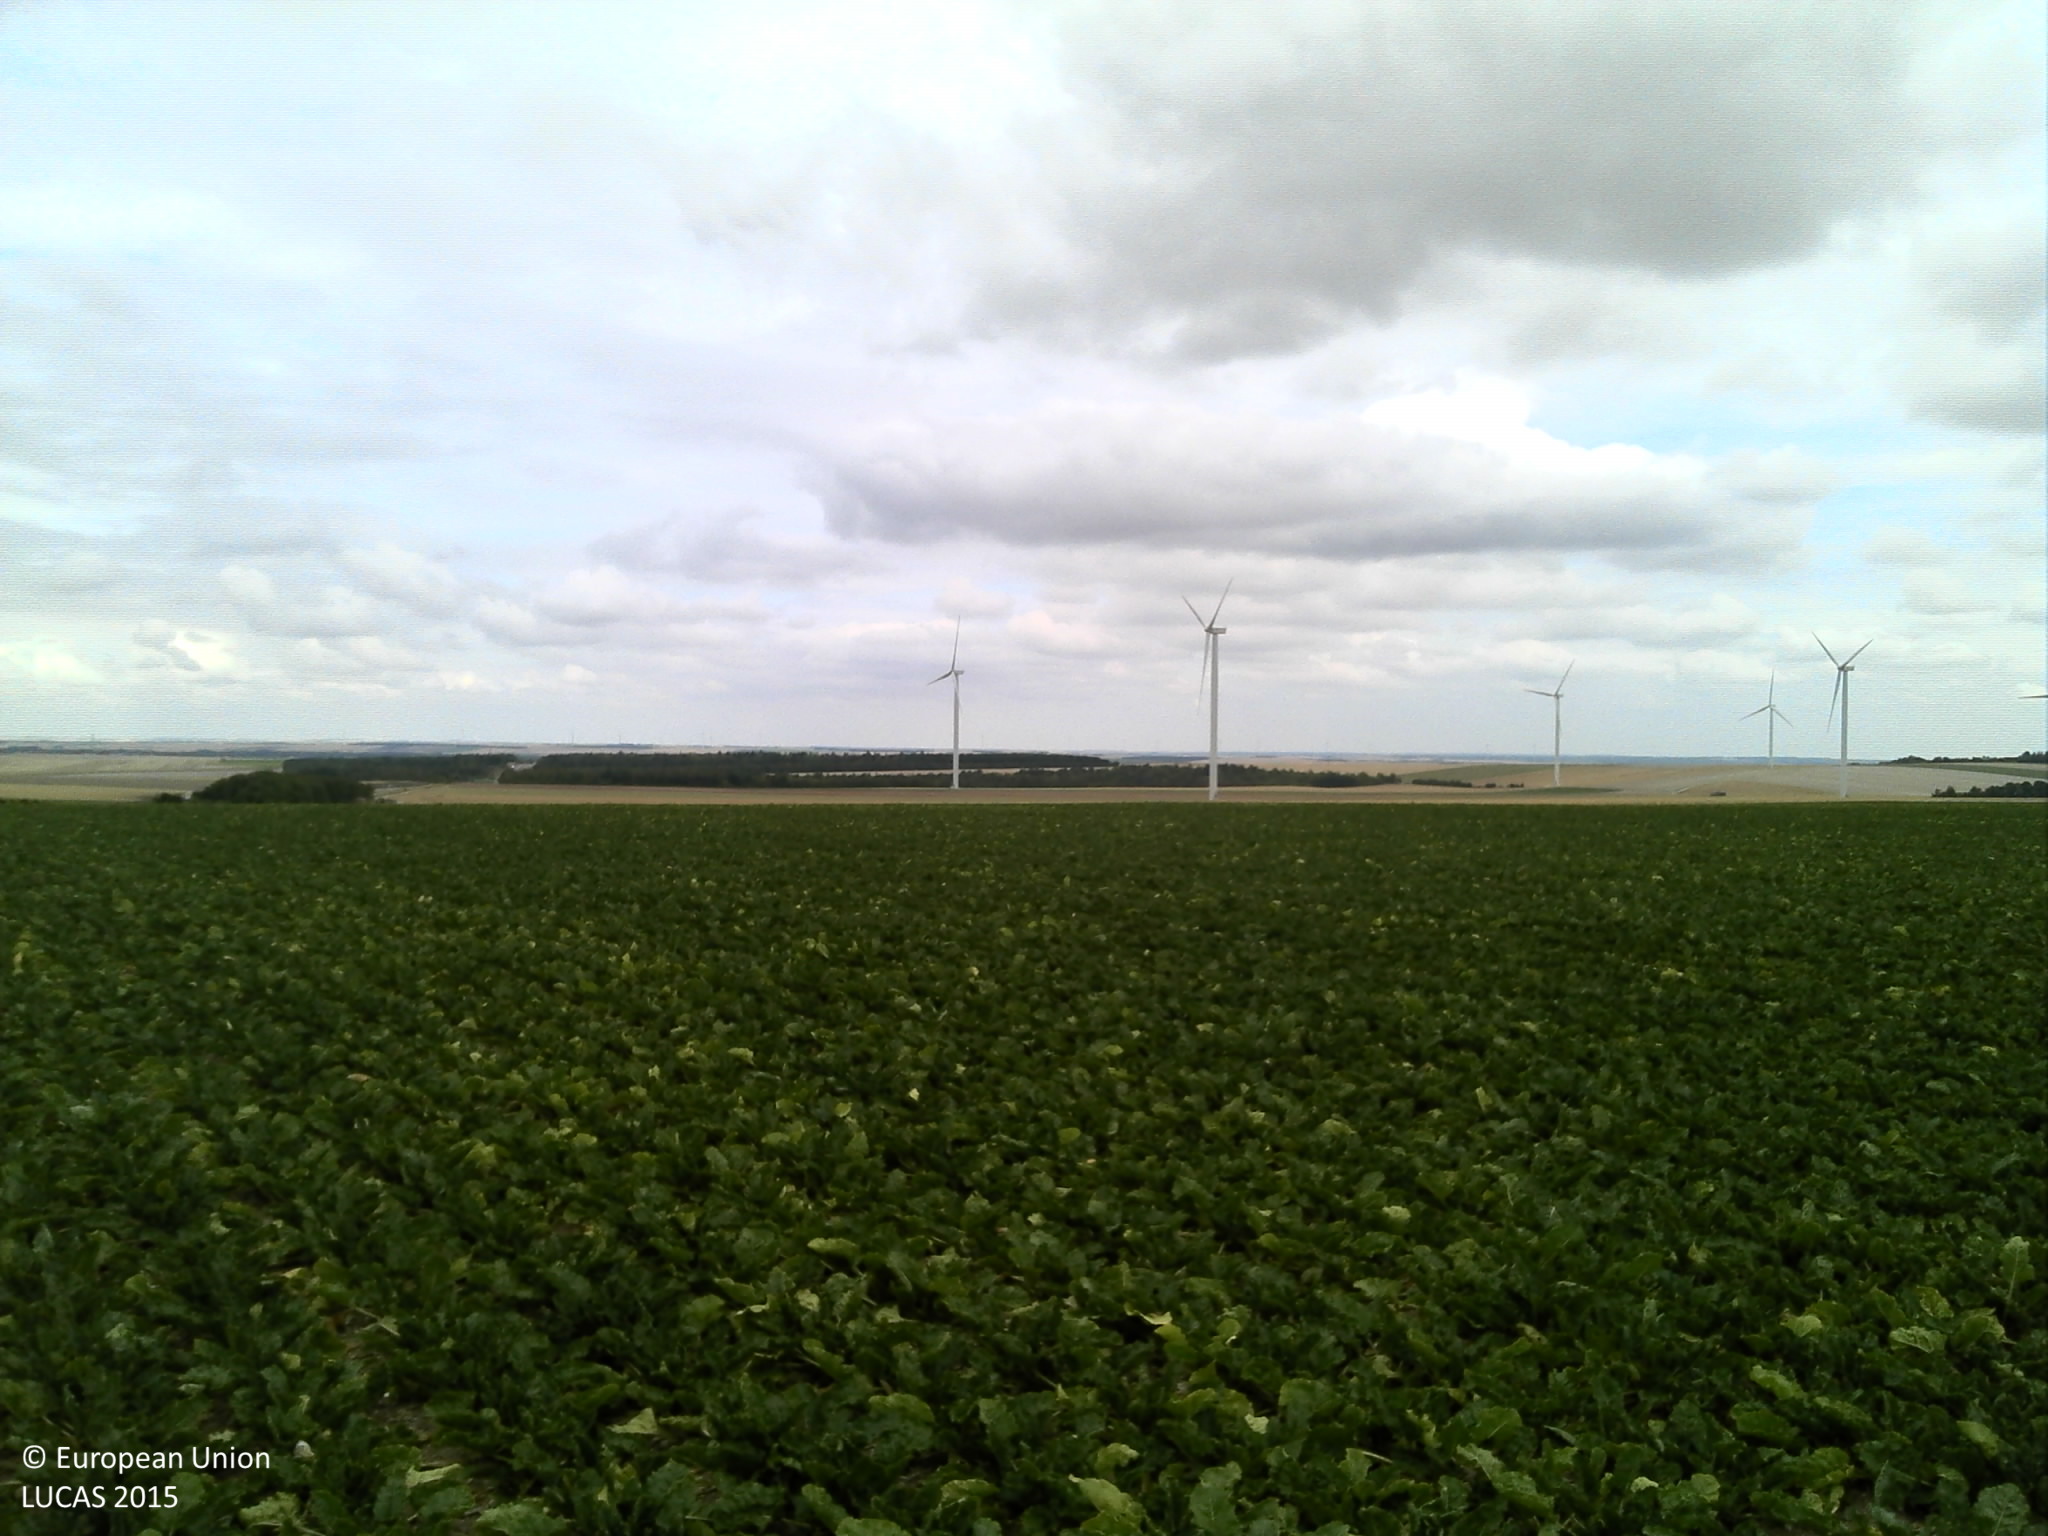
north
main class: Cropland
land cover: Sugar beet
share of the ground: > 75 %
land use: Agriculture (excluding fallow land and kitchen gardens)
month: August
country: FR
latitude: 48.4660
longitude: 4.1672
